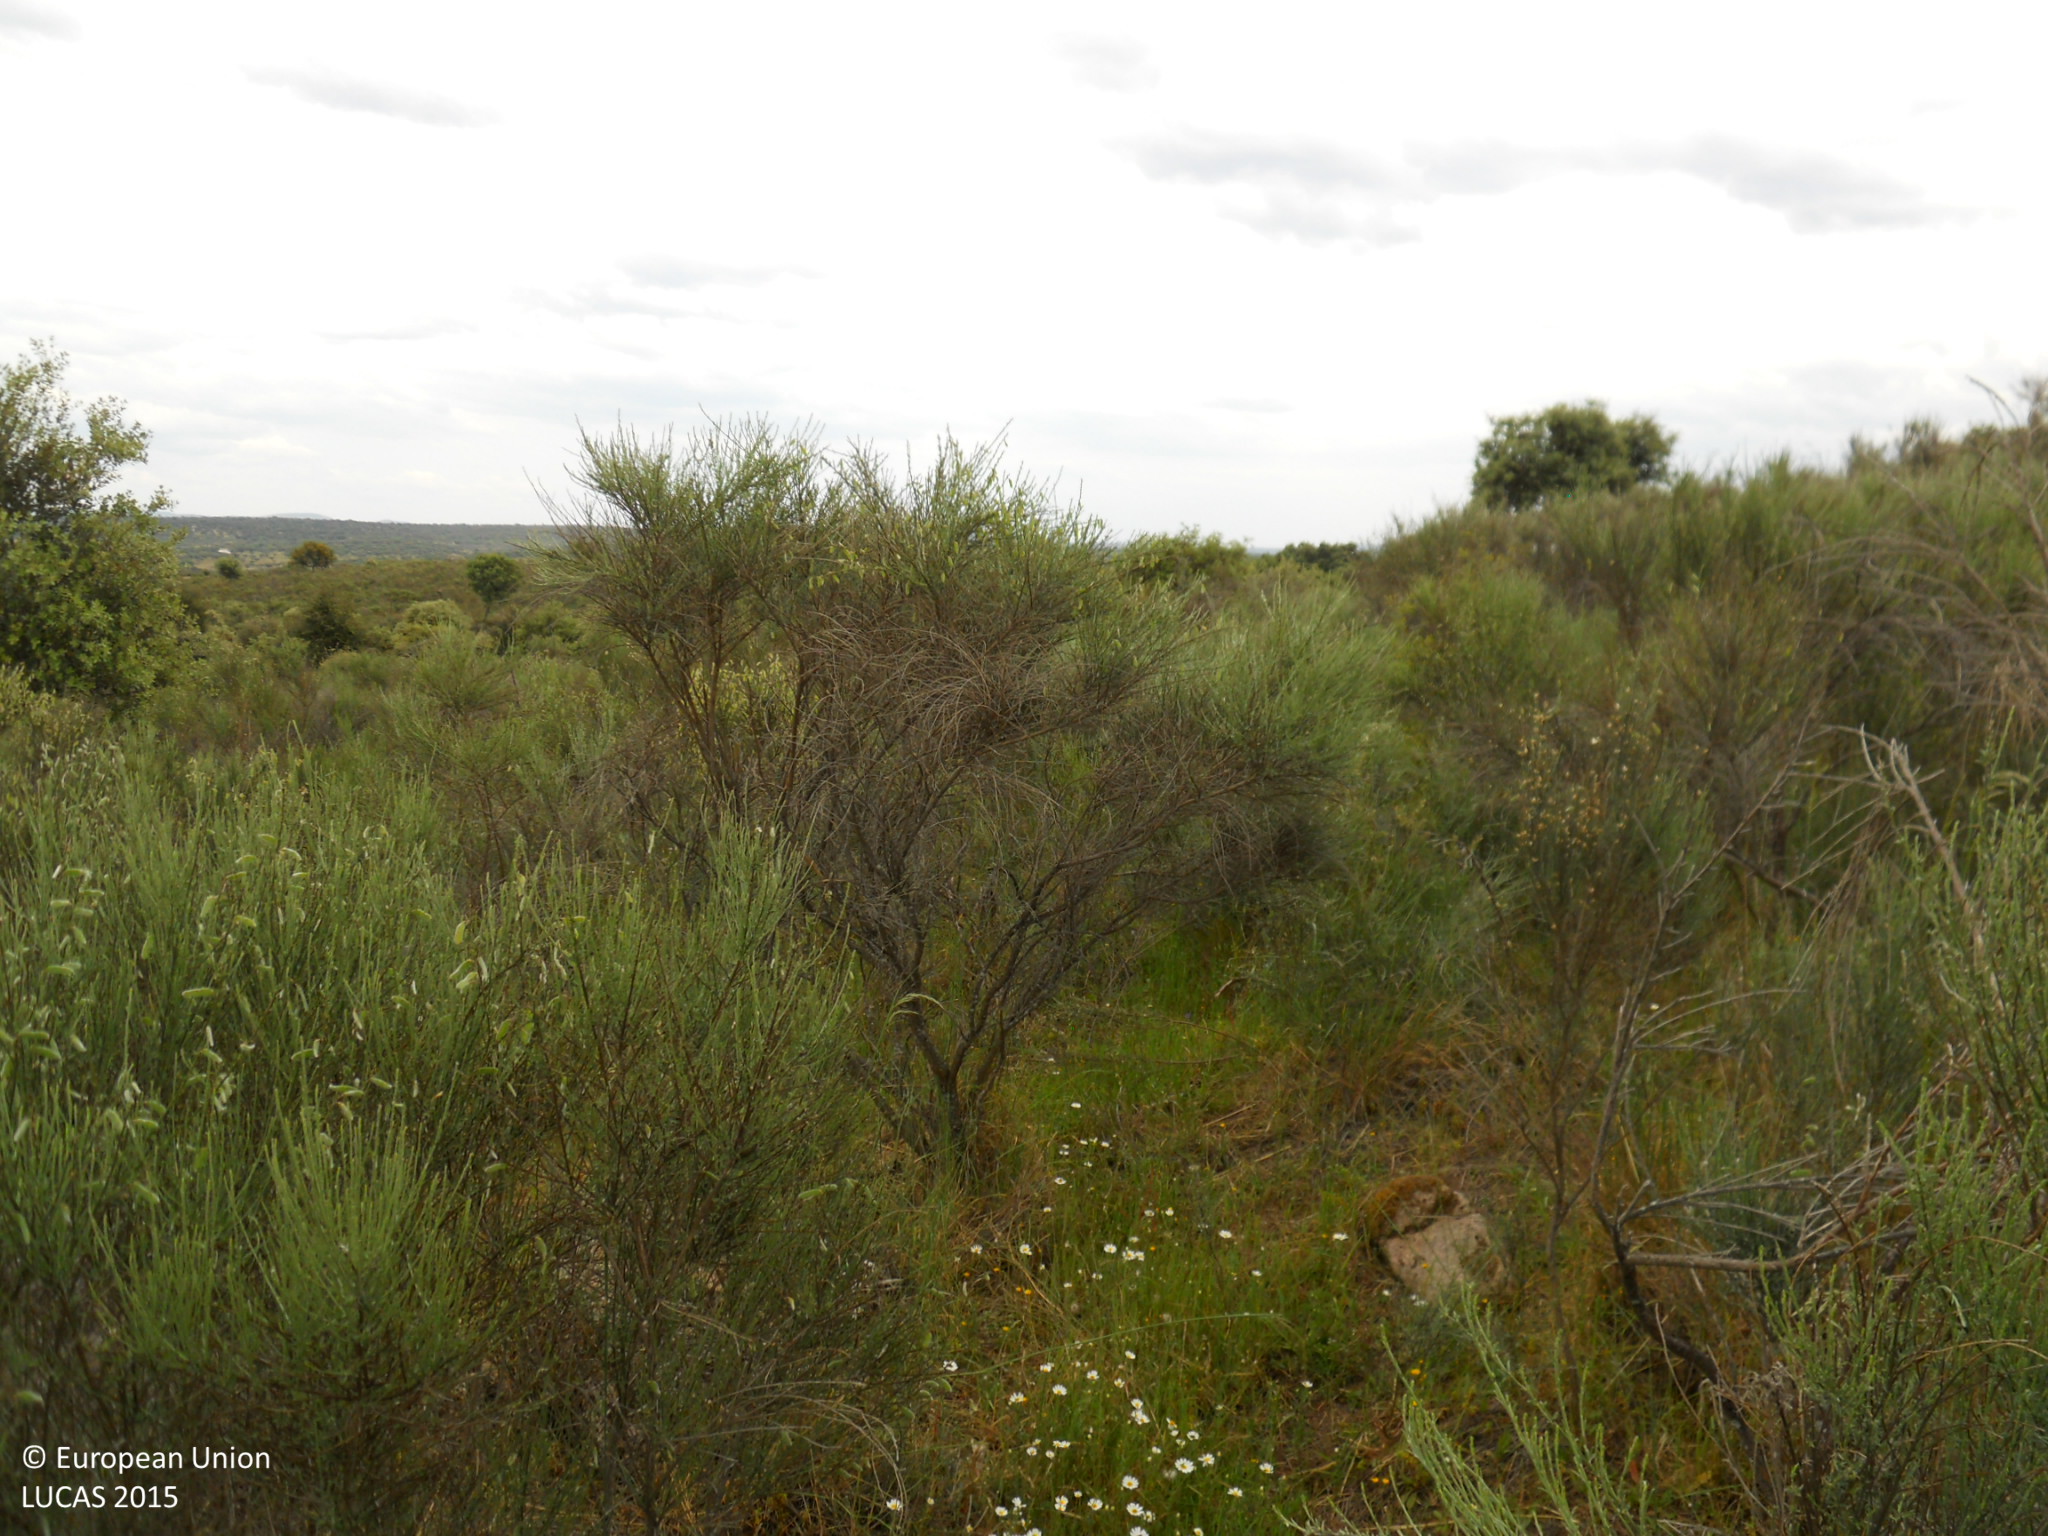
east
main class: Shrubland
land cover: Shrubland with sparse tree cover
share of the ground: > 75 %
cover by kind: shrubs 95 %, broadleaved forest trees 5 %
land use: Forestry
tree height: < 5 m
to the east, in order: Shrubland with sparse tree cover; Broadleaved woodland; Tracks; Broadleaved woodland; Fences; Shrubland with sparse tree cover
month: April
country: ES
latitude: 39.2698
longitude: -6.8936
